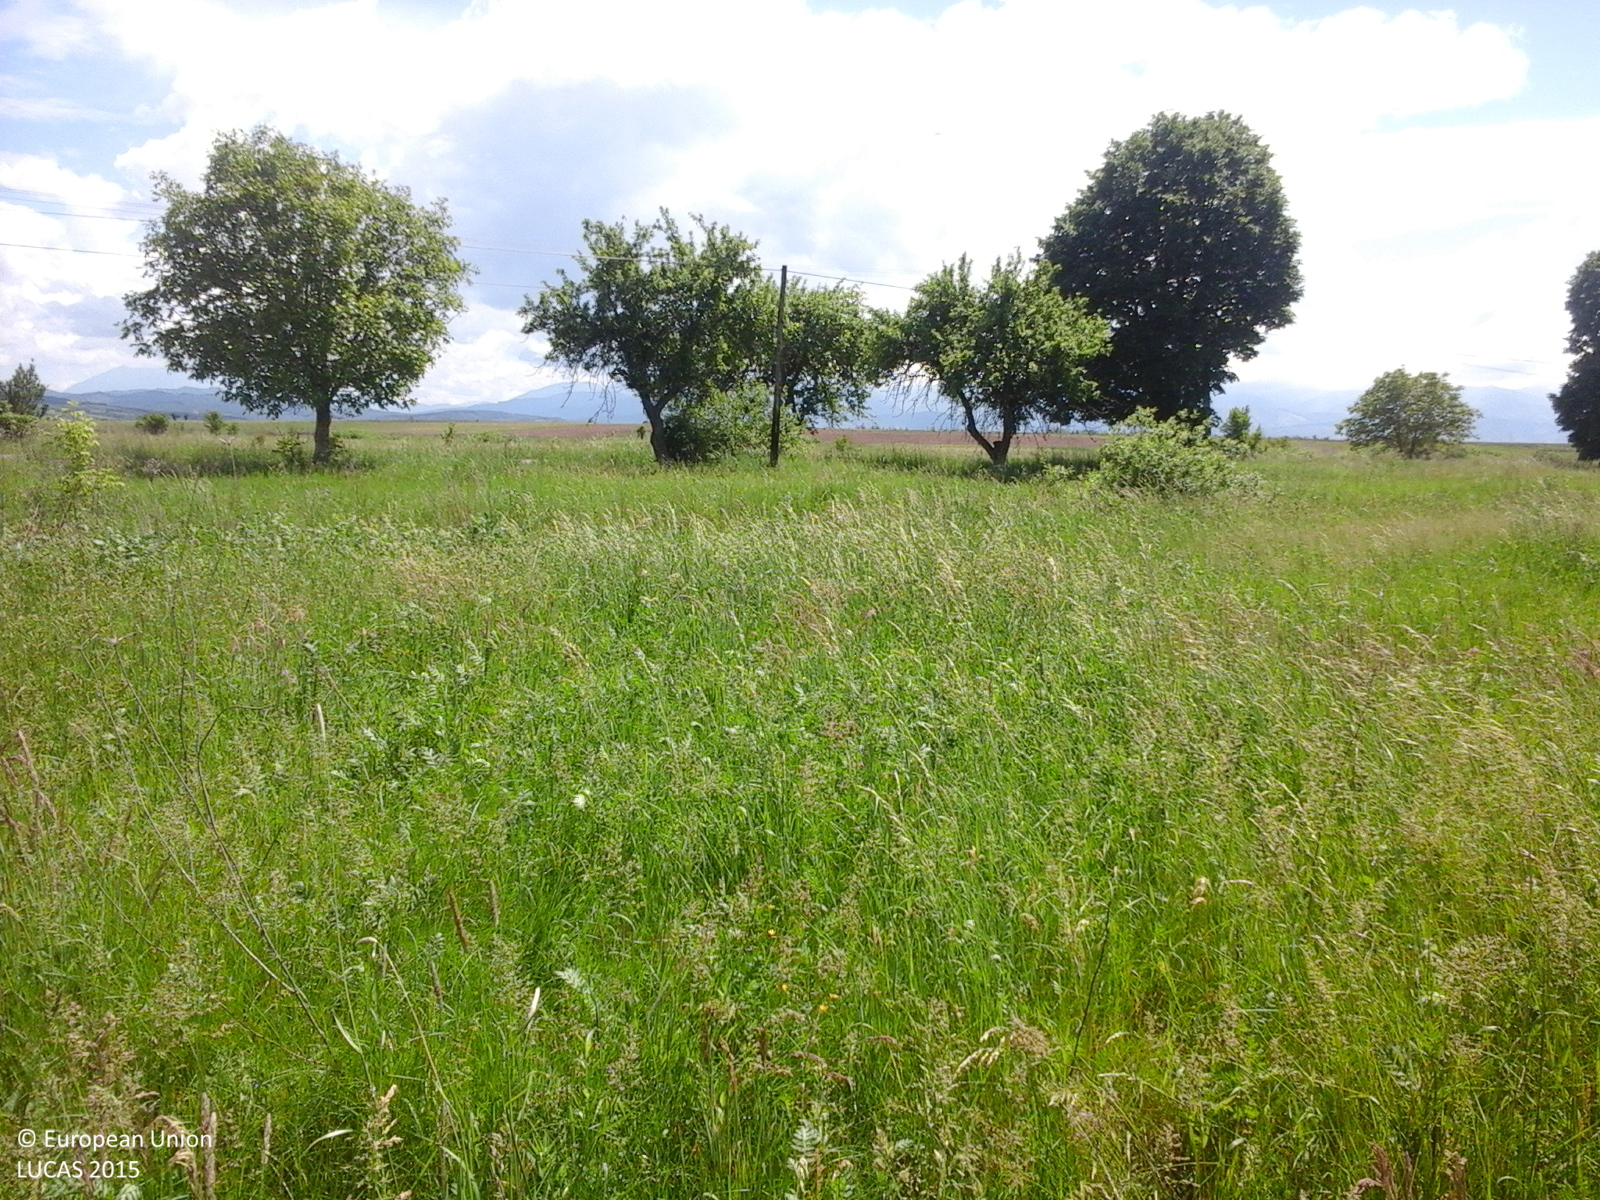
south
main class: Grassland
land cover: Spontaneously vegetated surfaces
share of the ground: > 75 %
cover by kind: herbaceous plants 100 %
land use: Fallow land
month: May
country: RO
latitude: 45.8466
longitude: 25.1752
